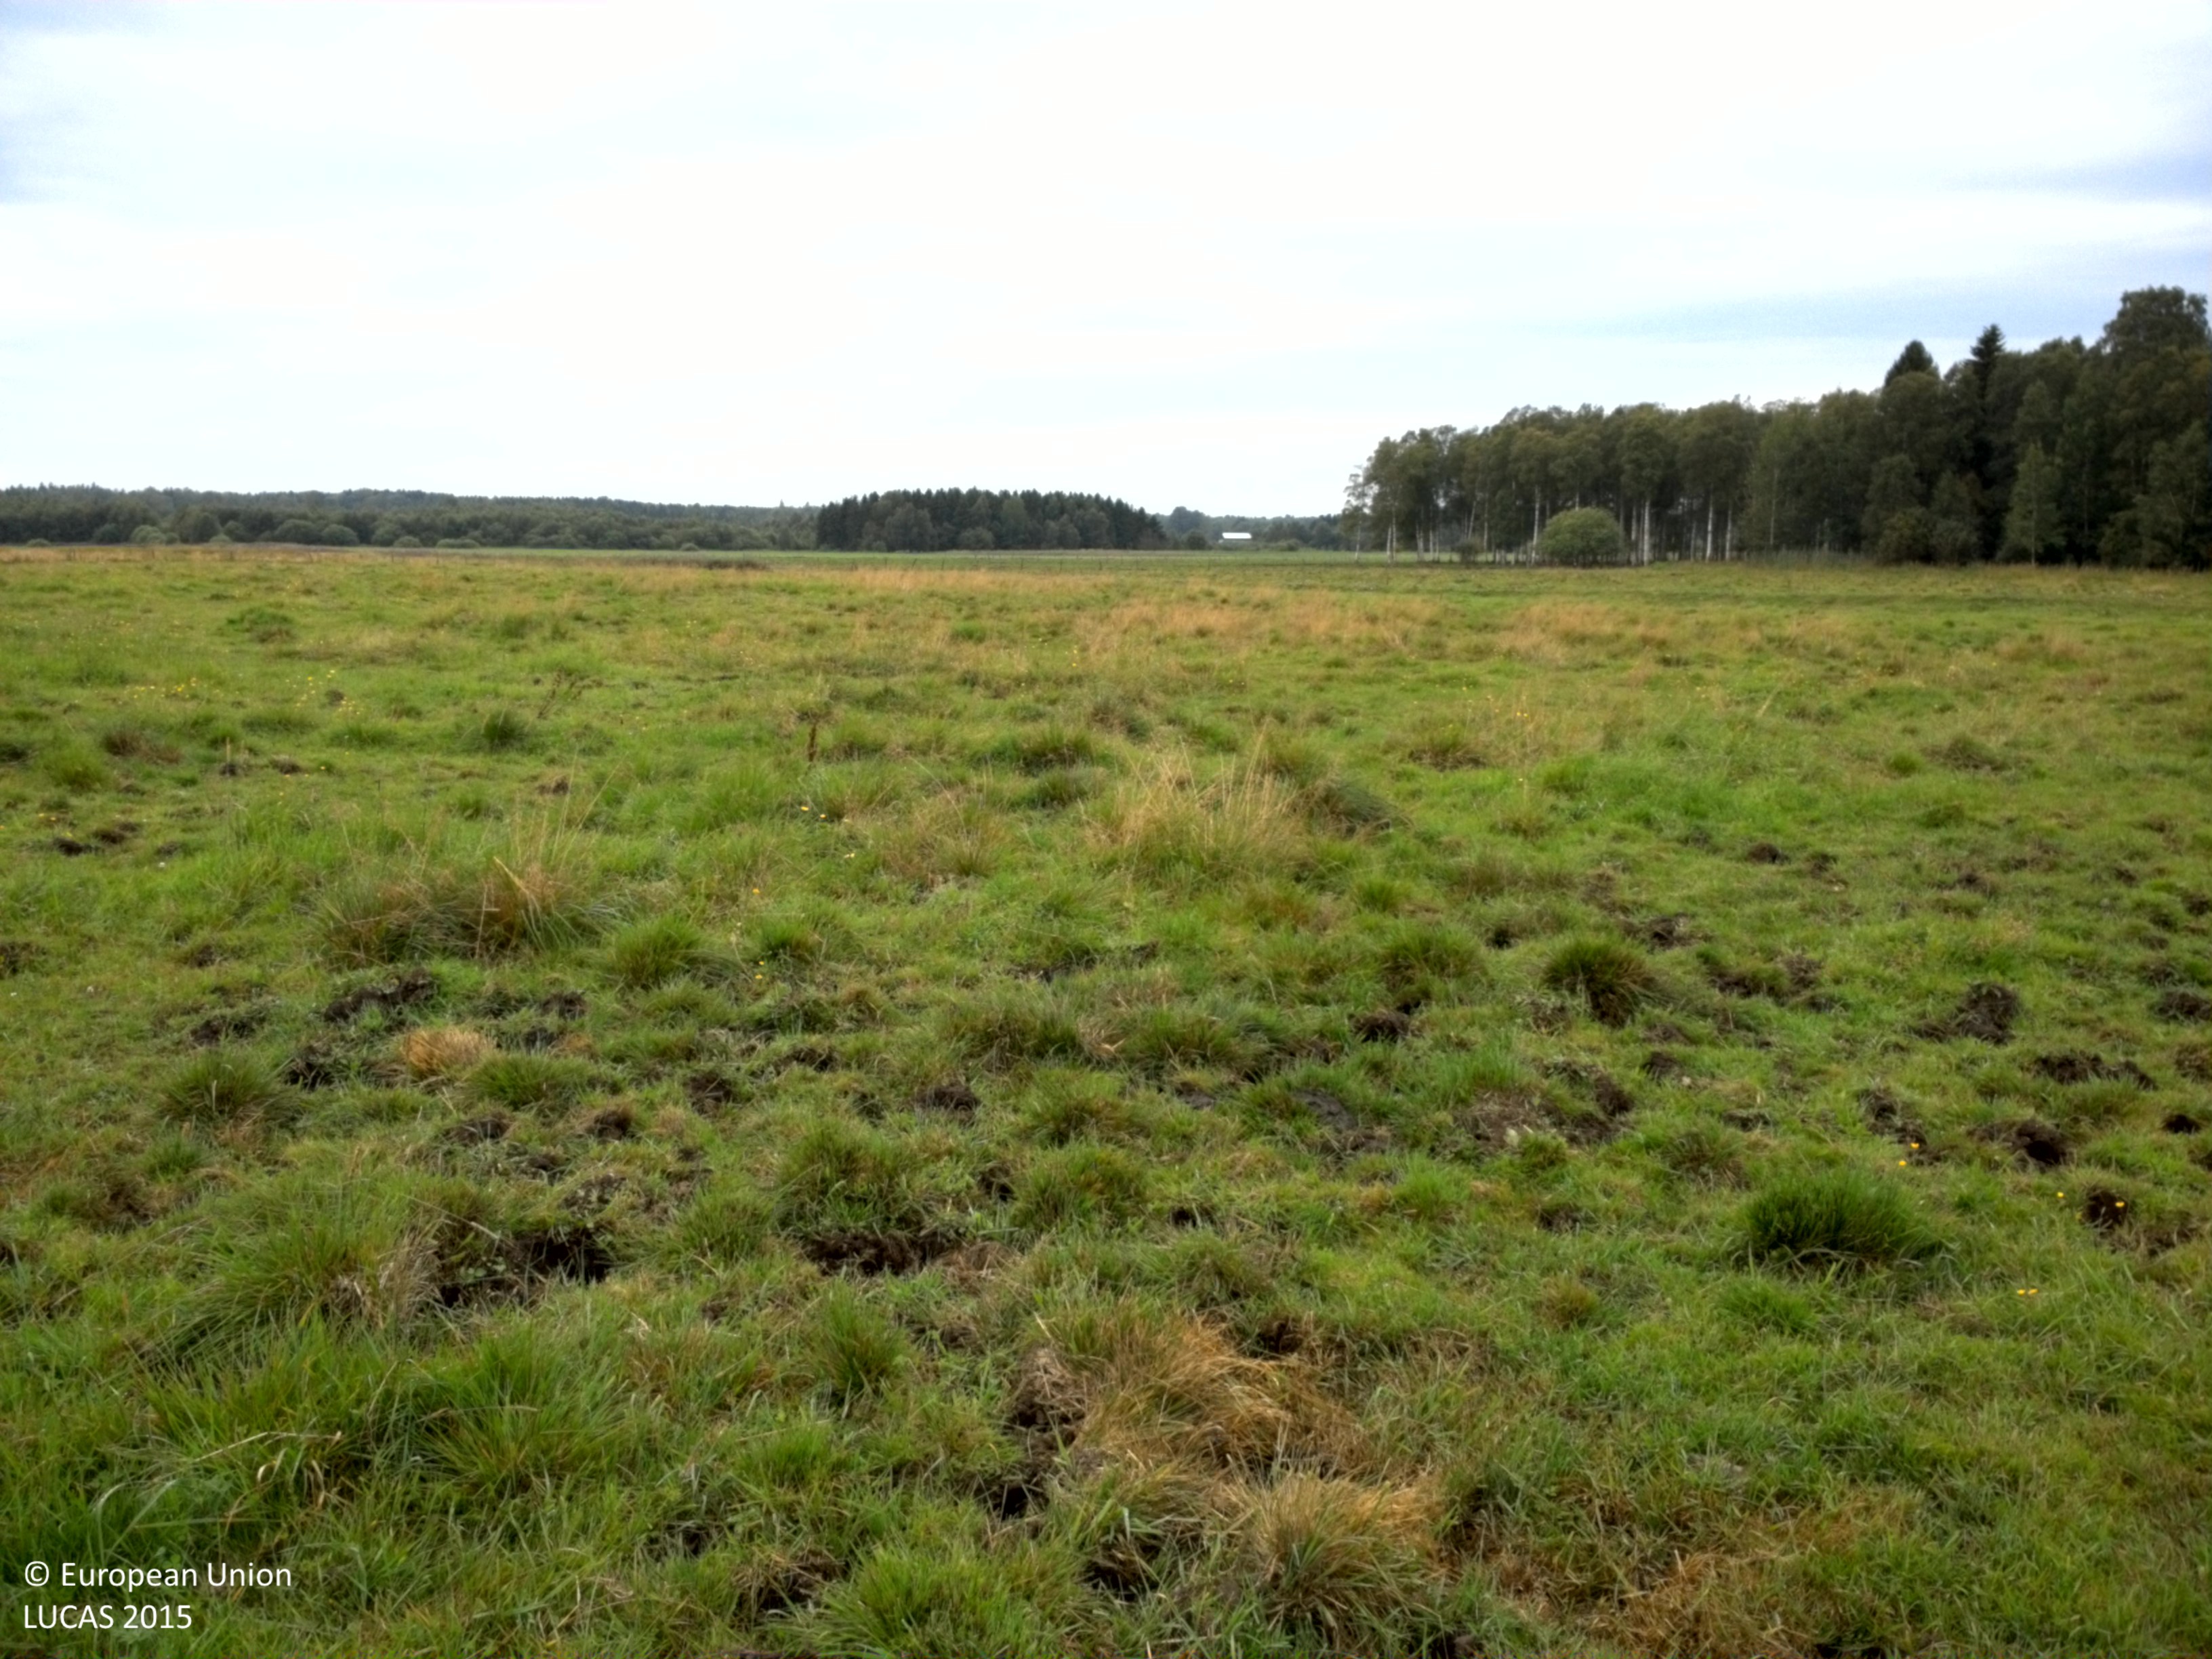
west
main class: Grassland
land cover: Grassland without tree/shrub cover
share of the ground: > 75 %
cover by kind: herbaceous plants 95 %, unconsolidated bare surface 5 %
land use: Agriculture (excluding fallow land and kitchen gardens)
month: August
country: SE
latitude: 59.8515
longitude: 16.4707
